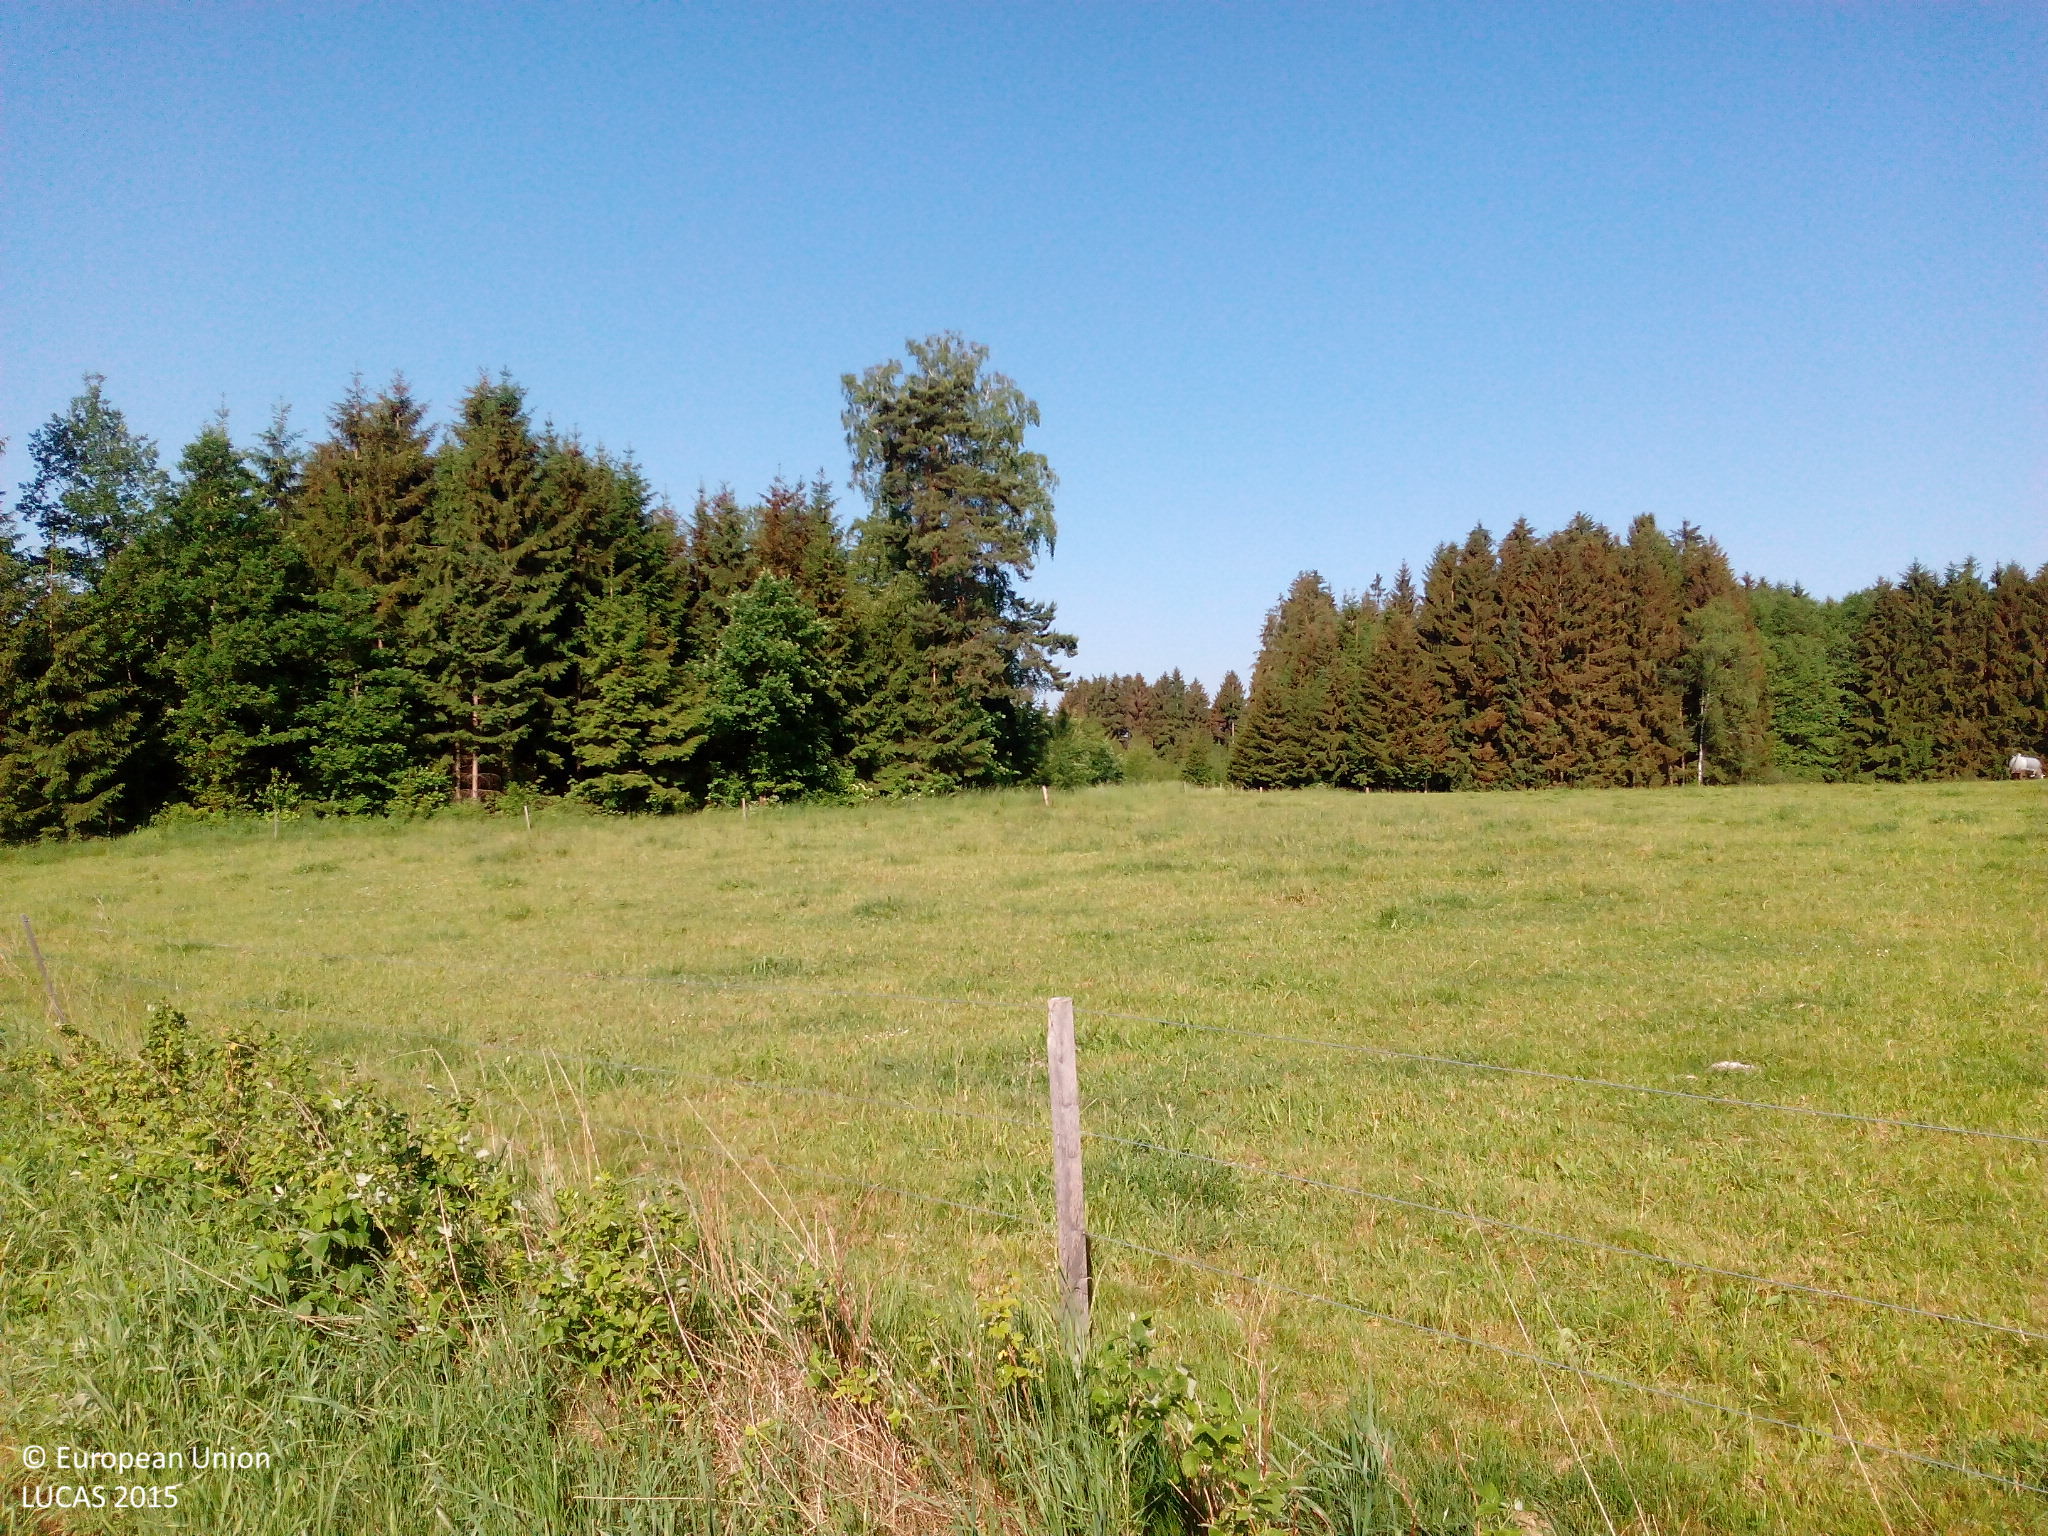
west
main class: Grassland
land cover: Grassland without tree/shrub cover
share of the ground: > 75 %
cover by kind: herbaceous plants 100 %
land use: Agriculture (excluding fallow land and kitchen gardens)
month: June
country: DE
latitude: 49.3306
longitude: 12.4351
